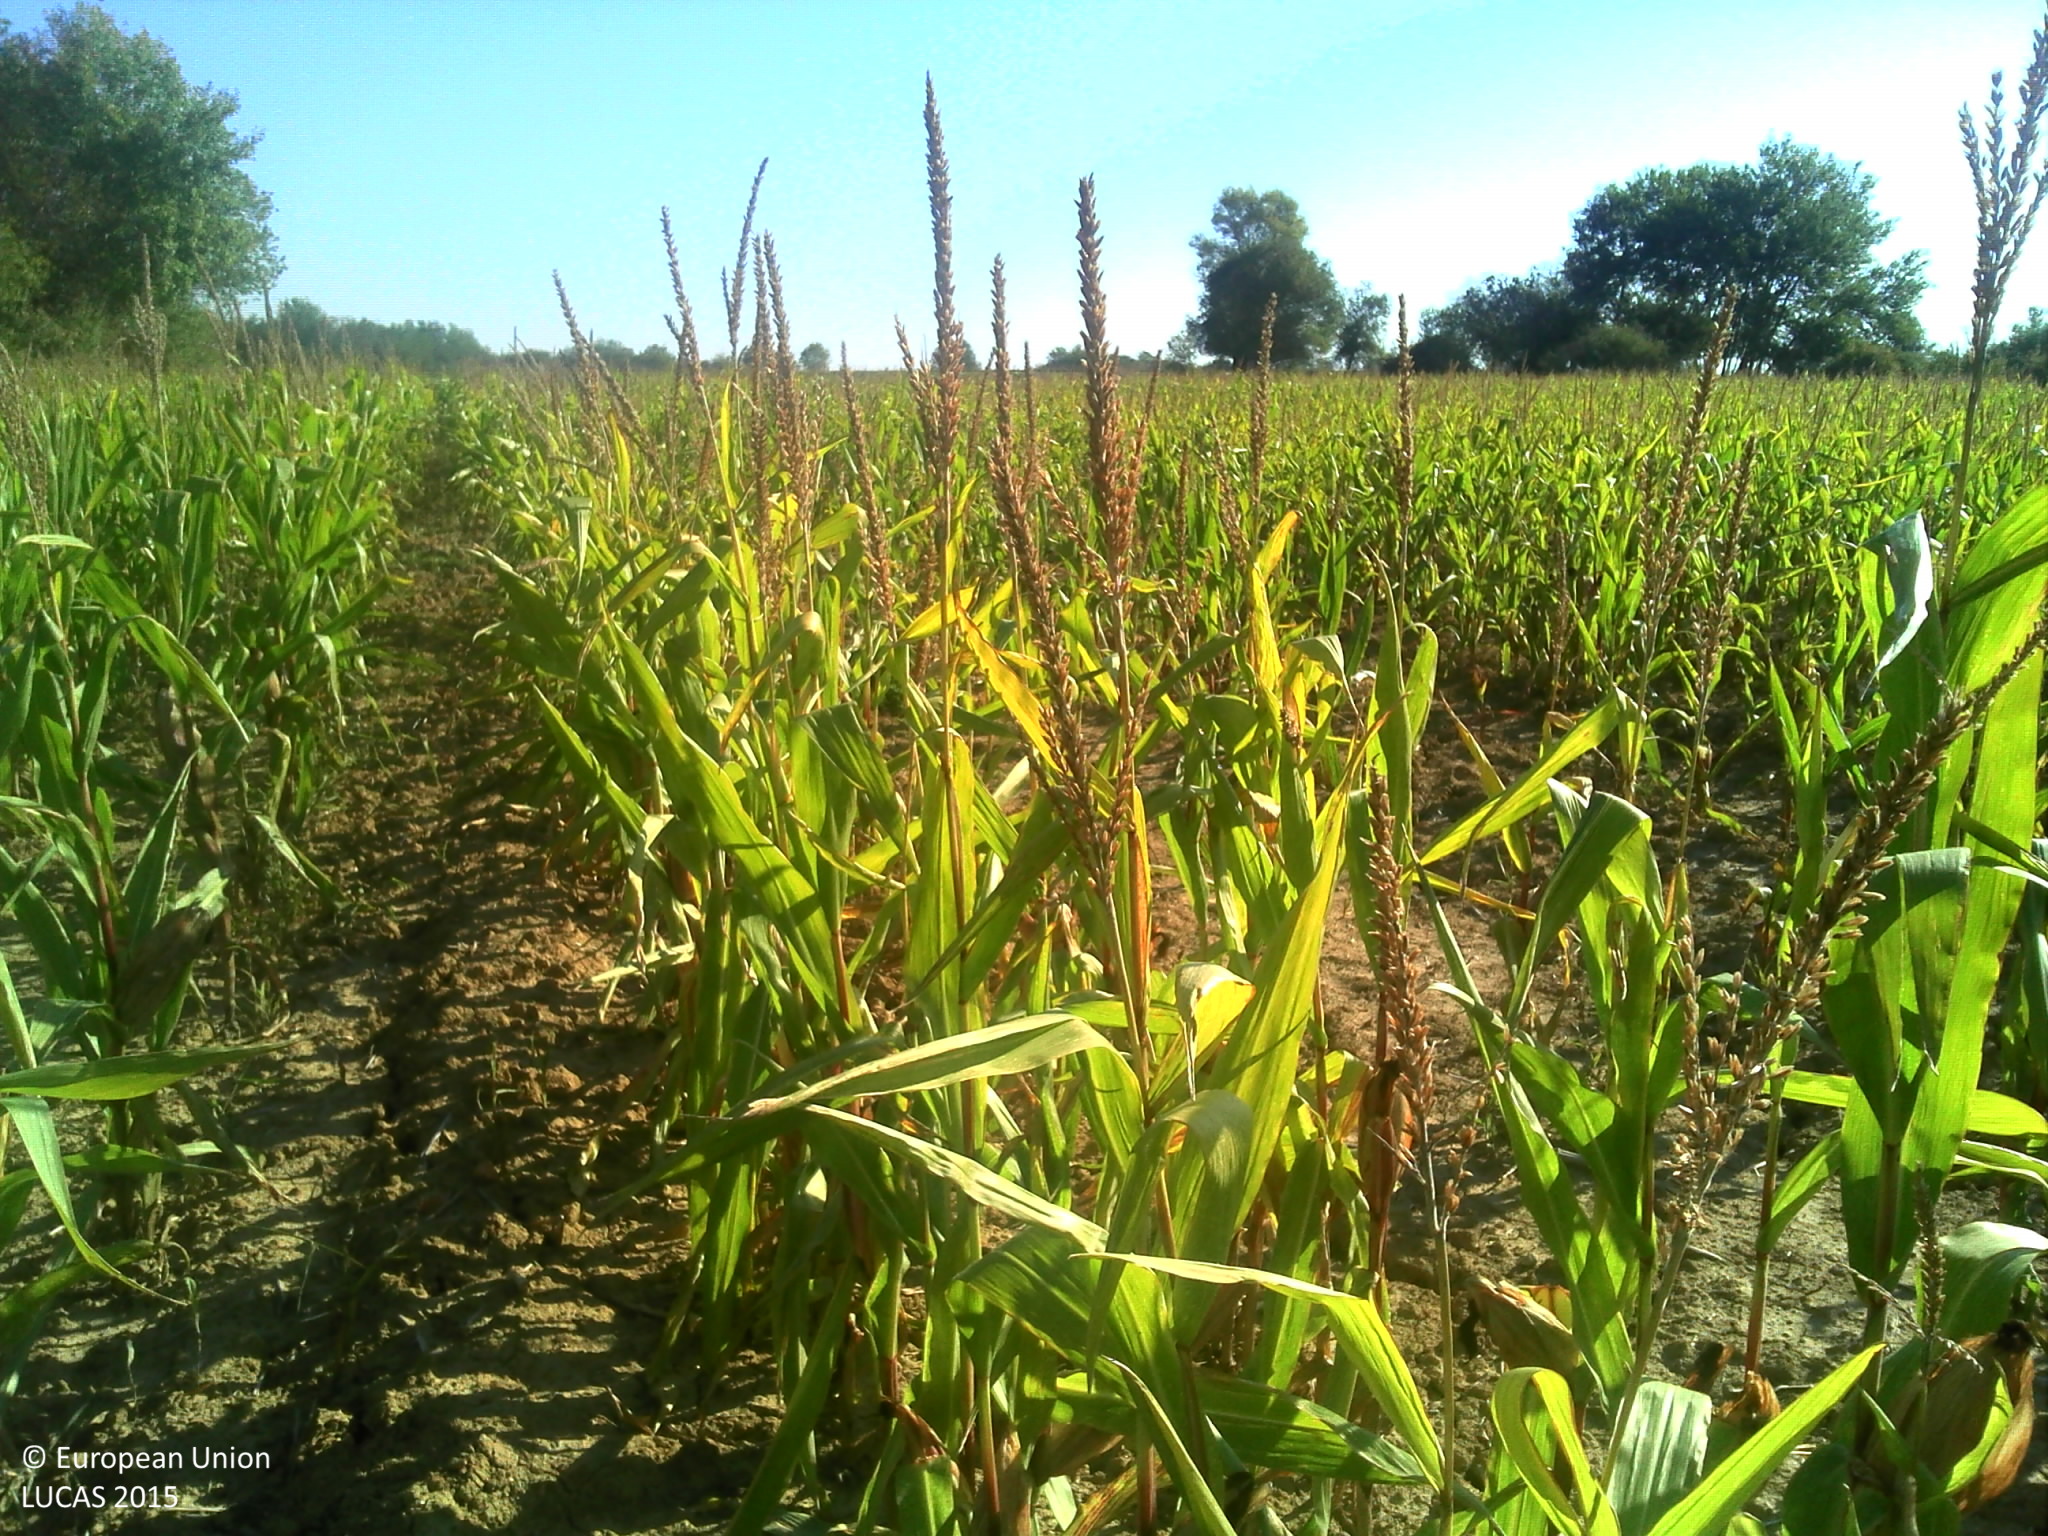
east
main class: Cropland
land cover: Maize
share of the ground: > 75 %
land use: Agriculture (excluding fallow land and kitchen gardens)
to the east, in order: Maize; Grass margins; Single bushes/trees; Artificial constructions; Fences; Shrubland with sparse tree cover; Broadleaved woodland; Grassland without tree/shrub cover; Tracks; Artificial constructions; Fences; Maize
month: October
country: FR
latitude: 48.6287
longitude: 6.2689
